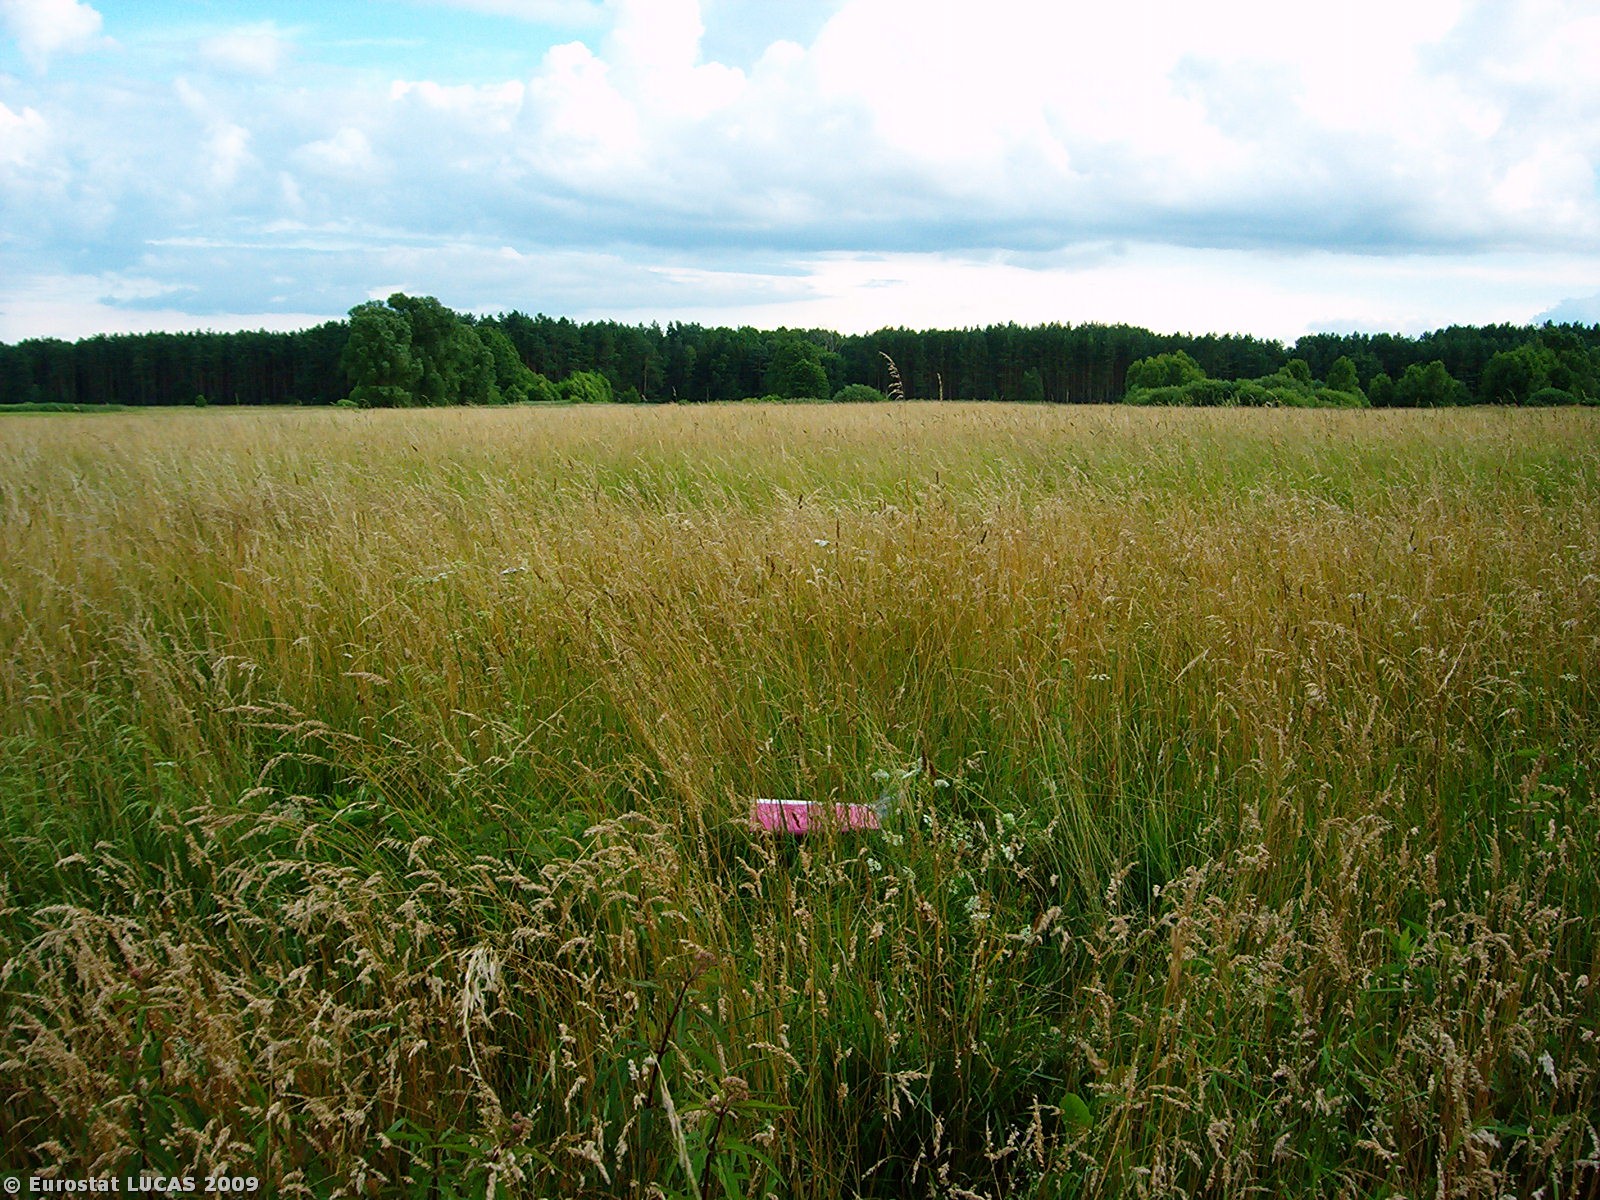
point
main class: Grassland
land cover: Grassland without tree/shrub cover
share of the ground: > 75 %
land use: Agriculture (excluding fallow land and kitchen gardens)
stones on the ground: < 10 %
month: July
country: PL
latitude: 52.4017
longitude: 15.7221
